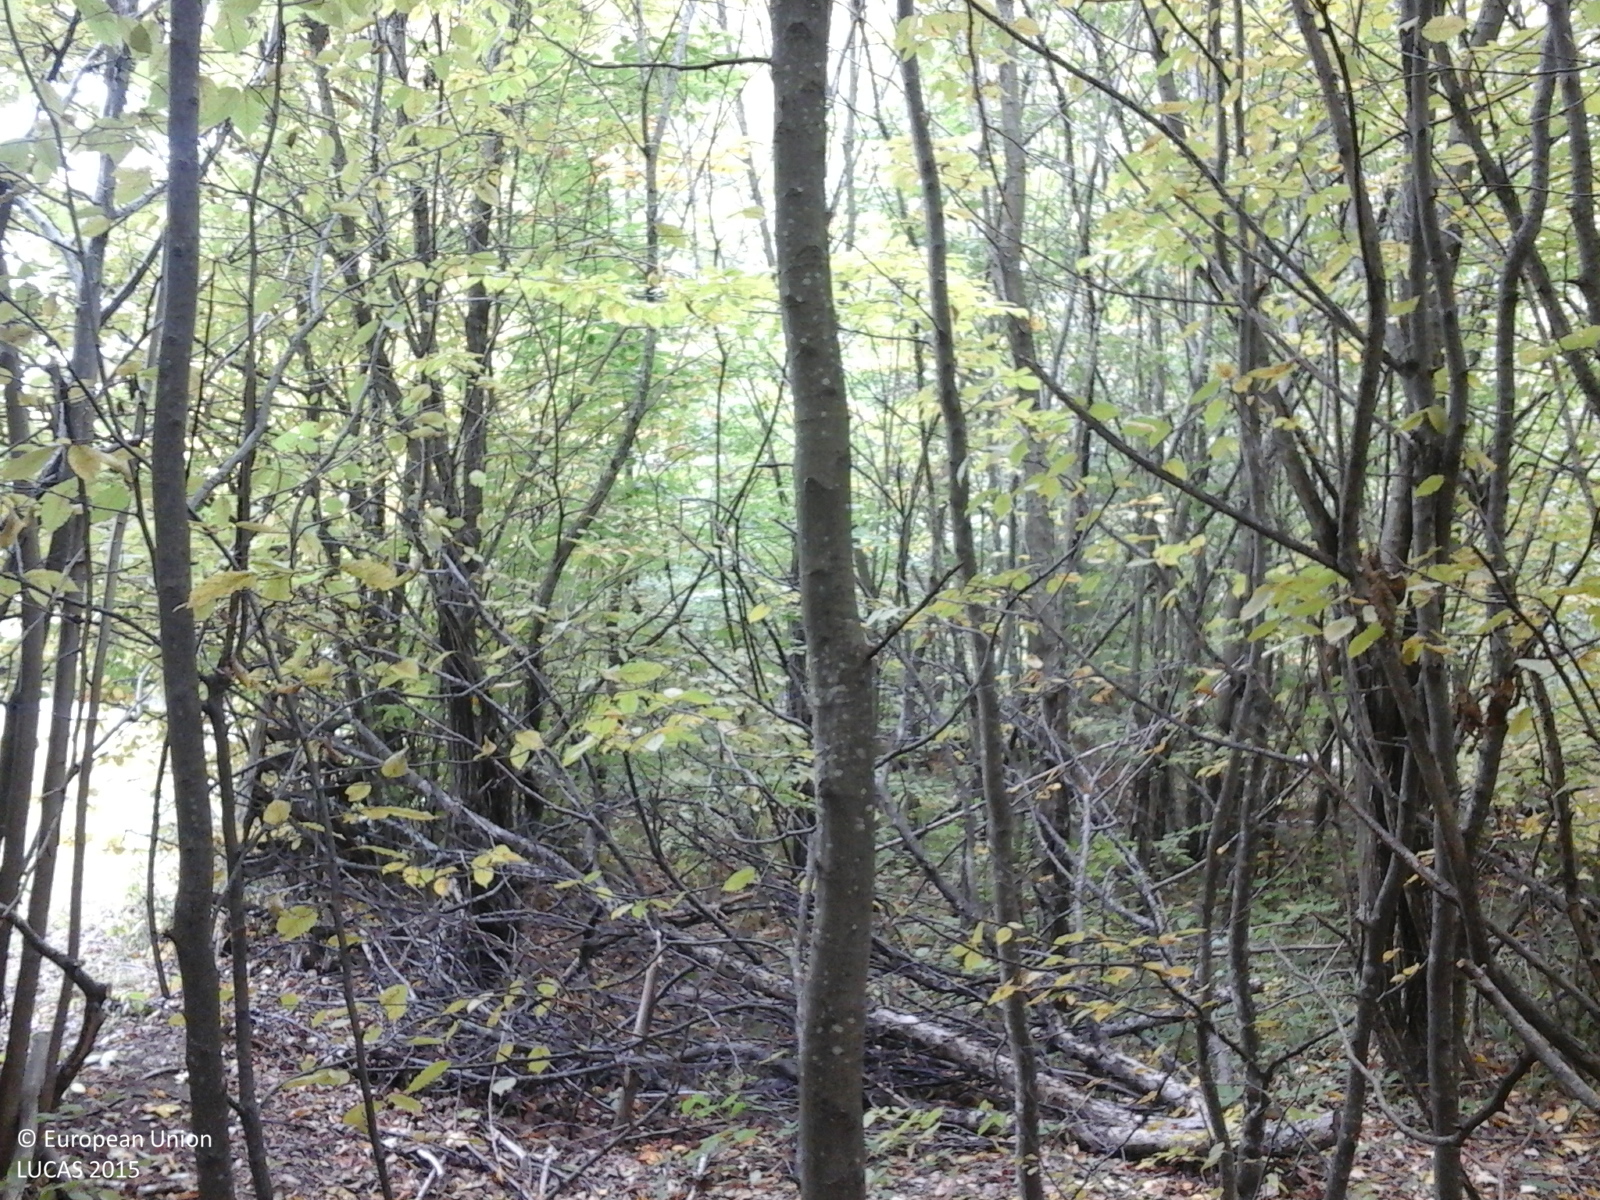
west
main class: Woodland
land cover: Broadleaved woodland
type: beech forest
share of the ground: > 75 %
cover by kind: broadleaved forest trees 100 %
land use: Forestry
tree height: > 5 m
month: October
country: RO
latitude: 46.4609
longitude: 25.4859
